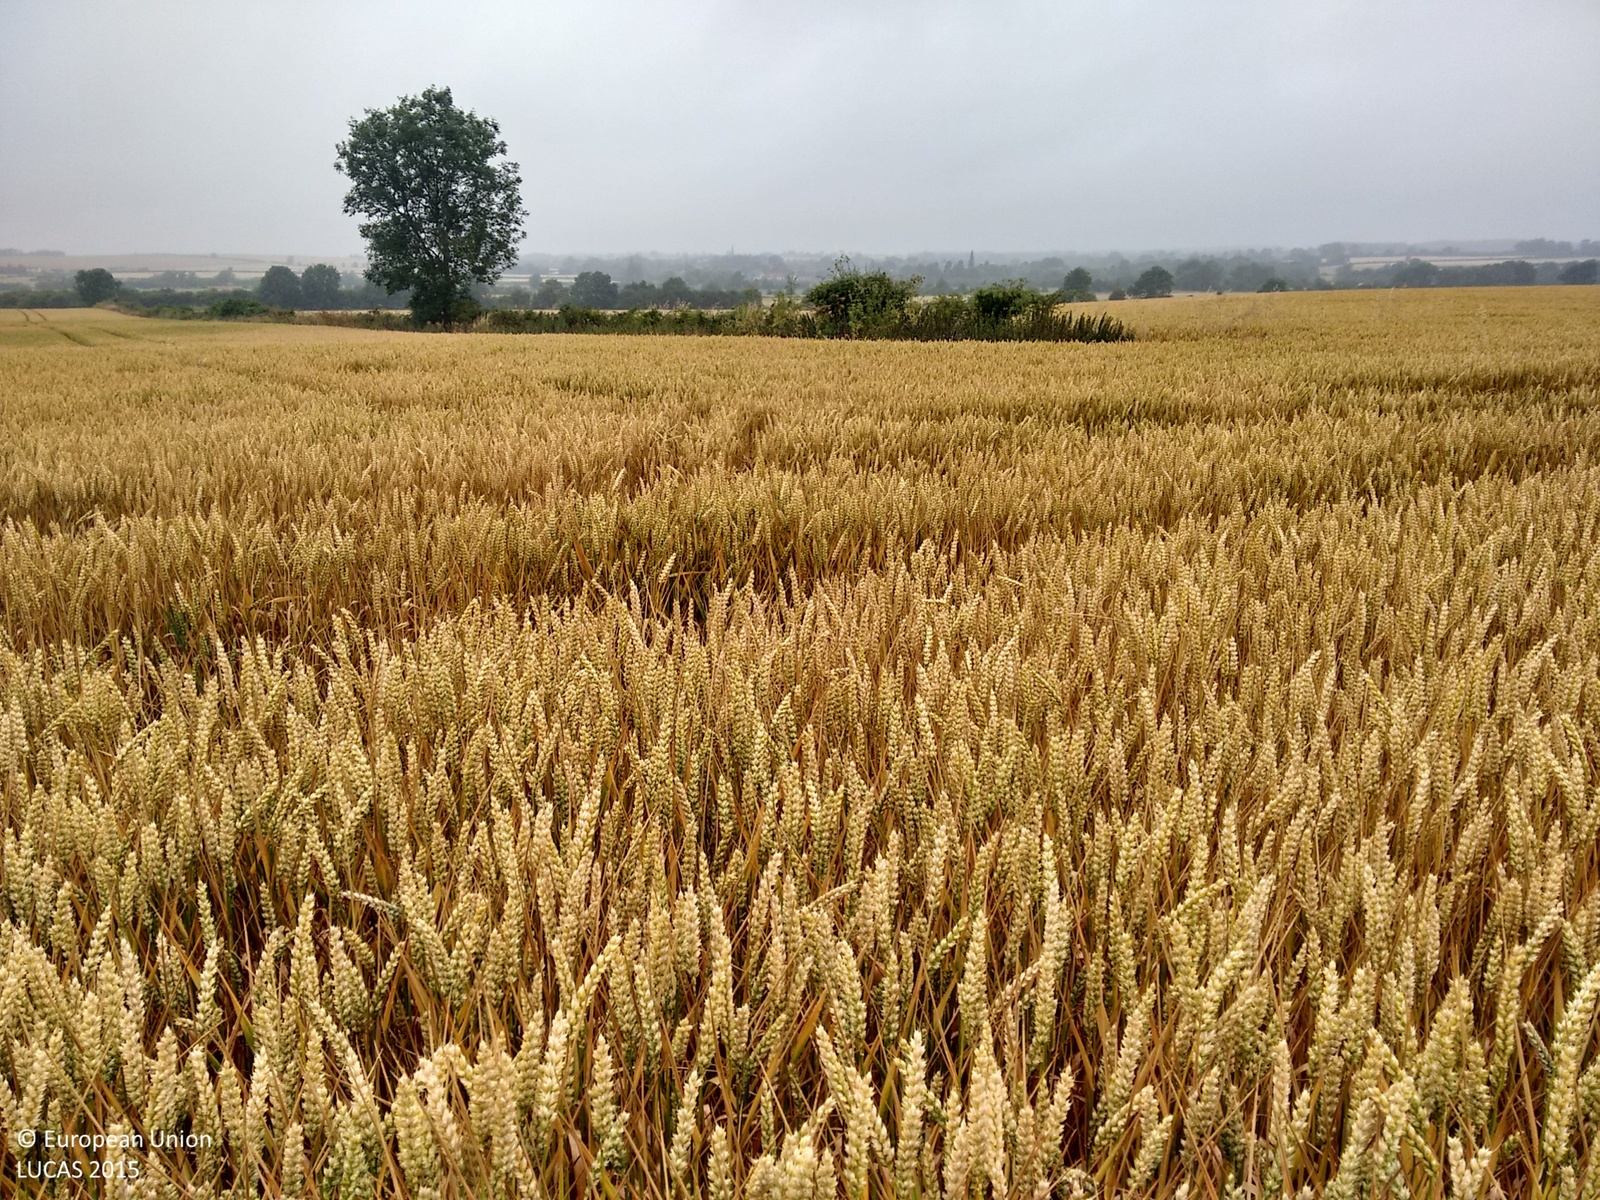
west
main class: Cropland
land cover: Common wheat
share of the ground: > 75 %
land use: Agriculture (excluding fallow land and kitchen gardens)
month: July
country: GB
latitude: 52.5535
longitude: -0.4053
